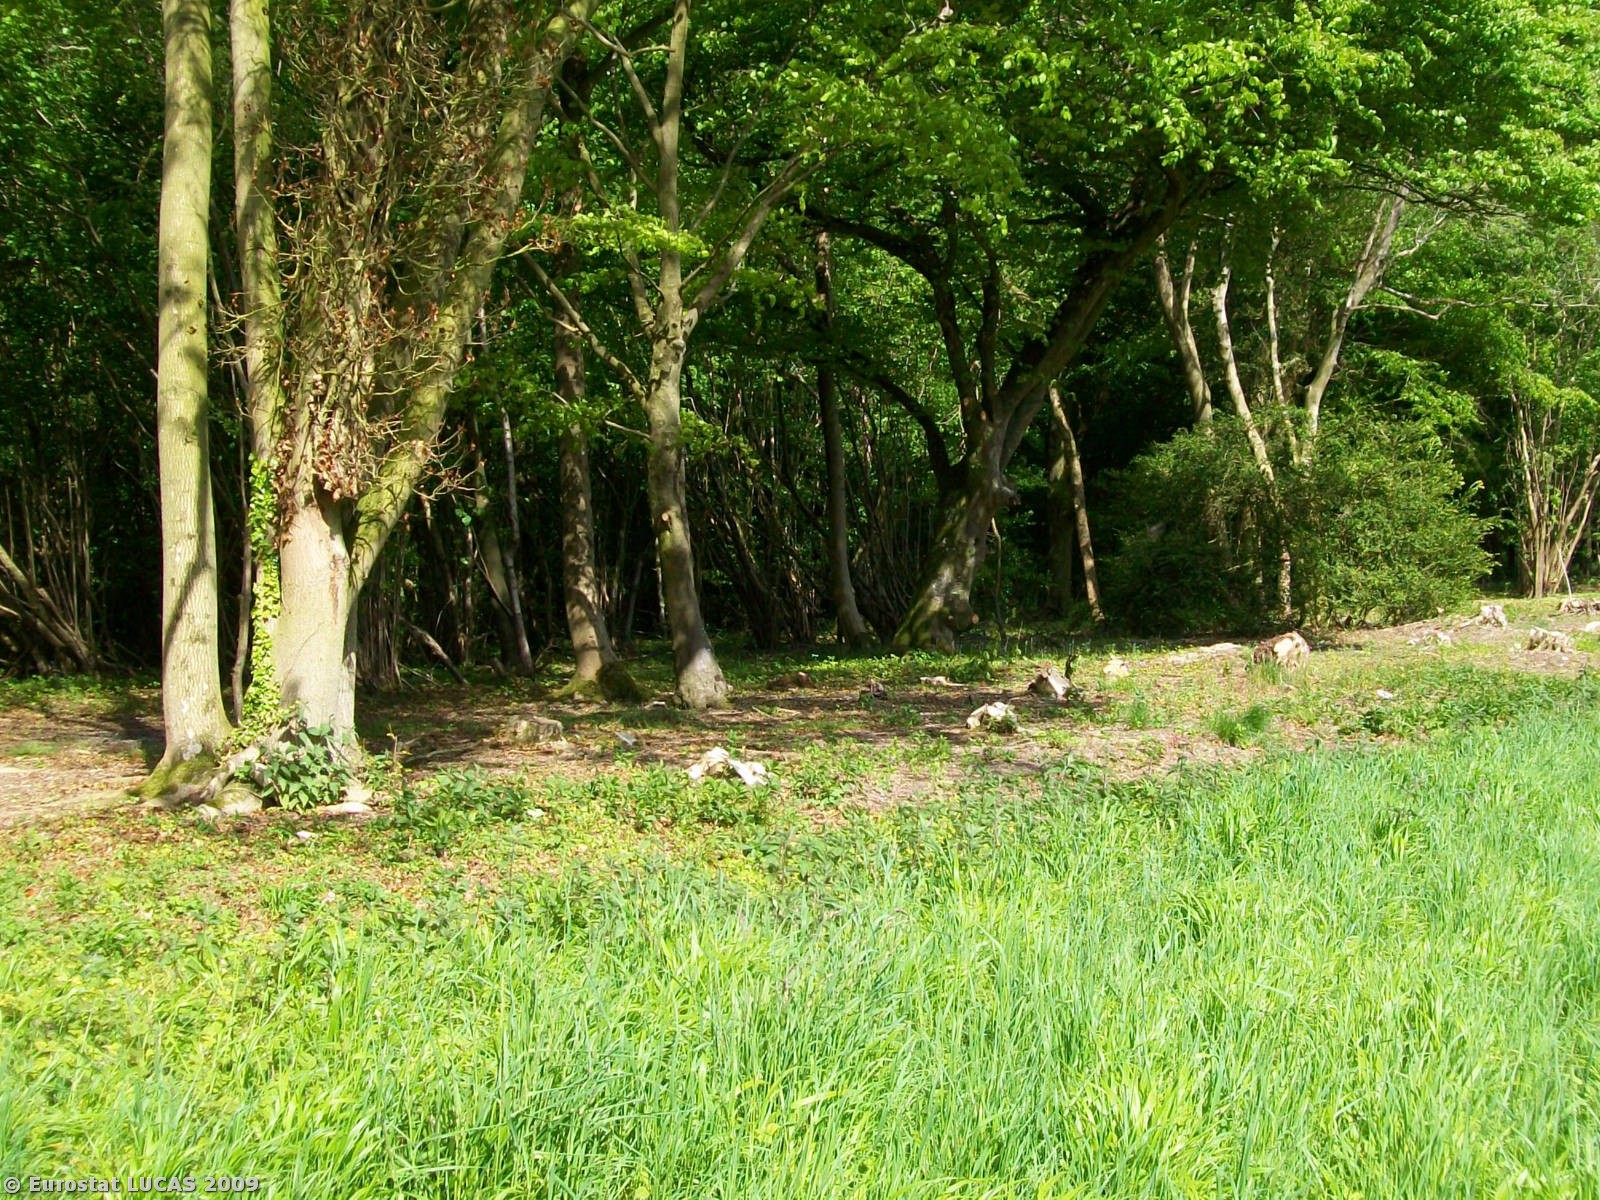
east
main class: Grassland
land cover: Grassland without tree/shrub cover
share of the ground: > 75 %
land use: Agriculture (excluding fallow land and kitchen gardens)
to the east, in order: Grassland without tree/shrub cover; Fences; Broadleaved woodland
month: May
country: GB
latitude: 51.0775
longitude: -2.1504
